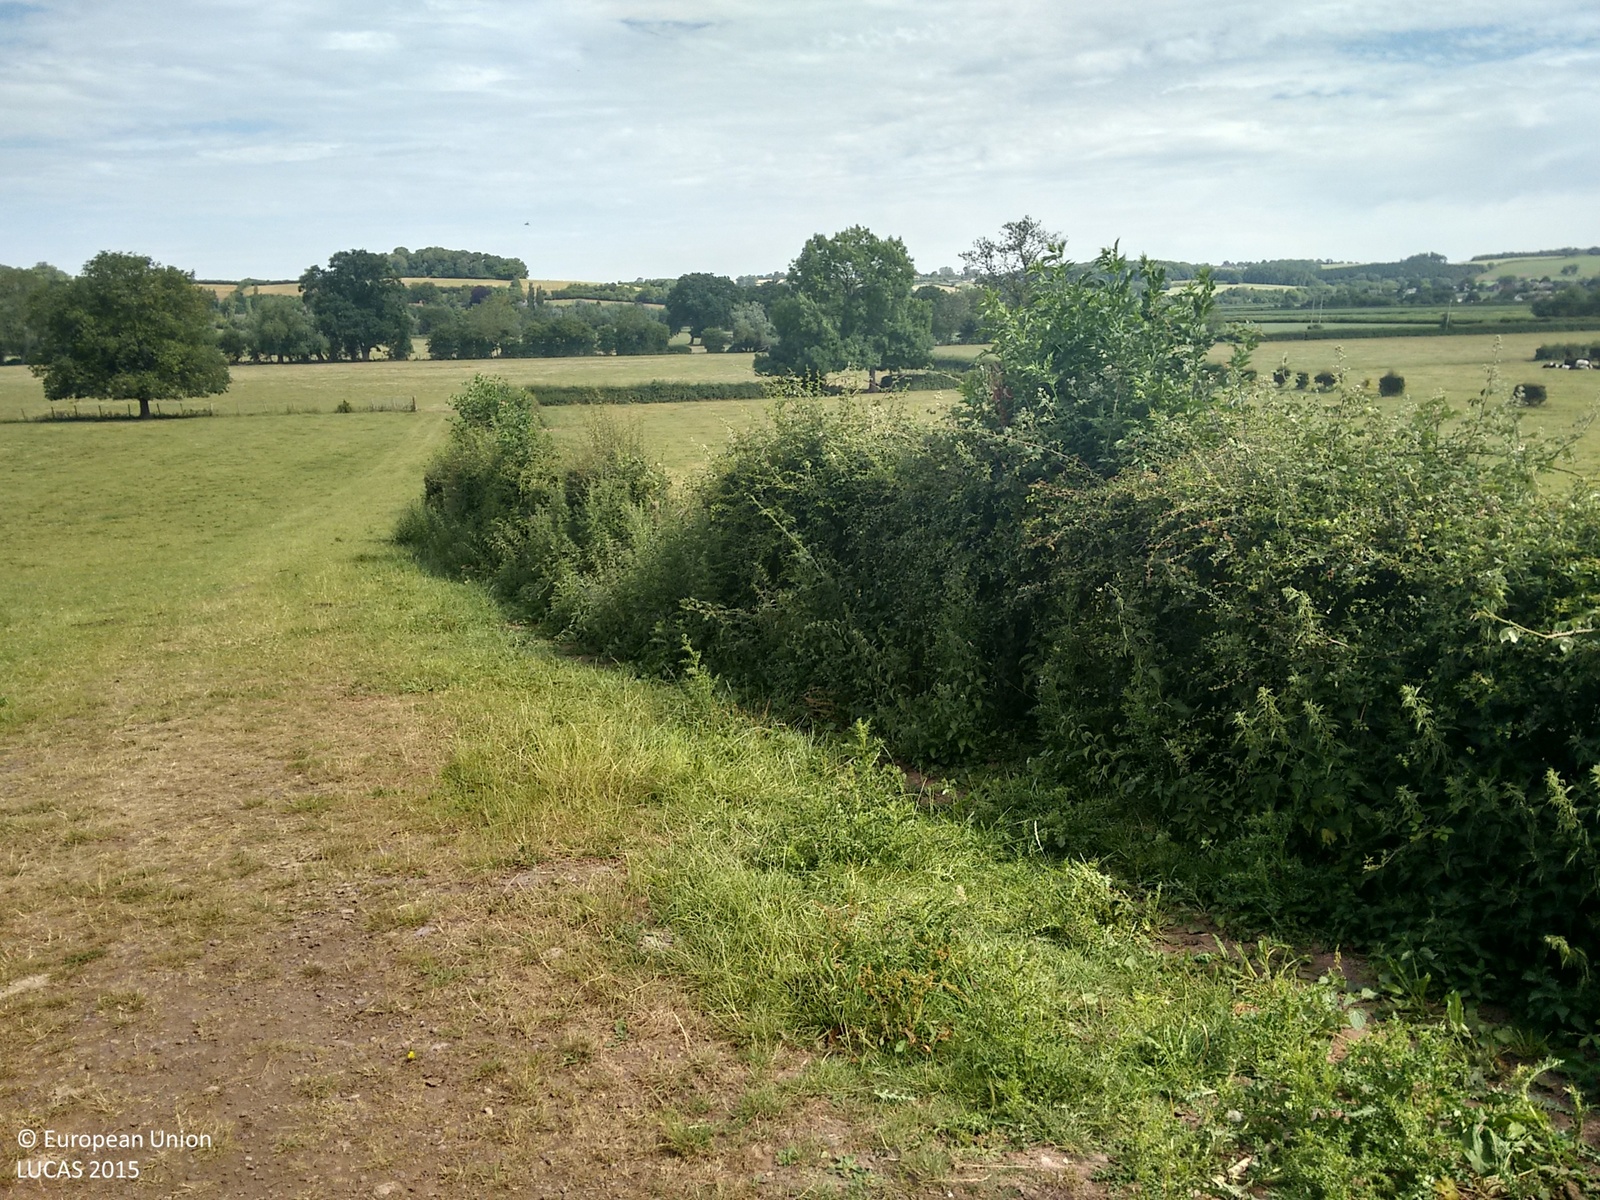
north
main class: Grassland
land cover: Grassland without tree/shrub cover
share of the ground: > 75 %
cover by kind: herbaceous plants 100 %
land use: Agriculture (excluding fallow land and kitchen gardens)
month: July
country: GB
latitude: 52.1491
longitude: -2.6818
